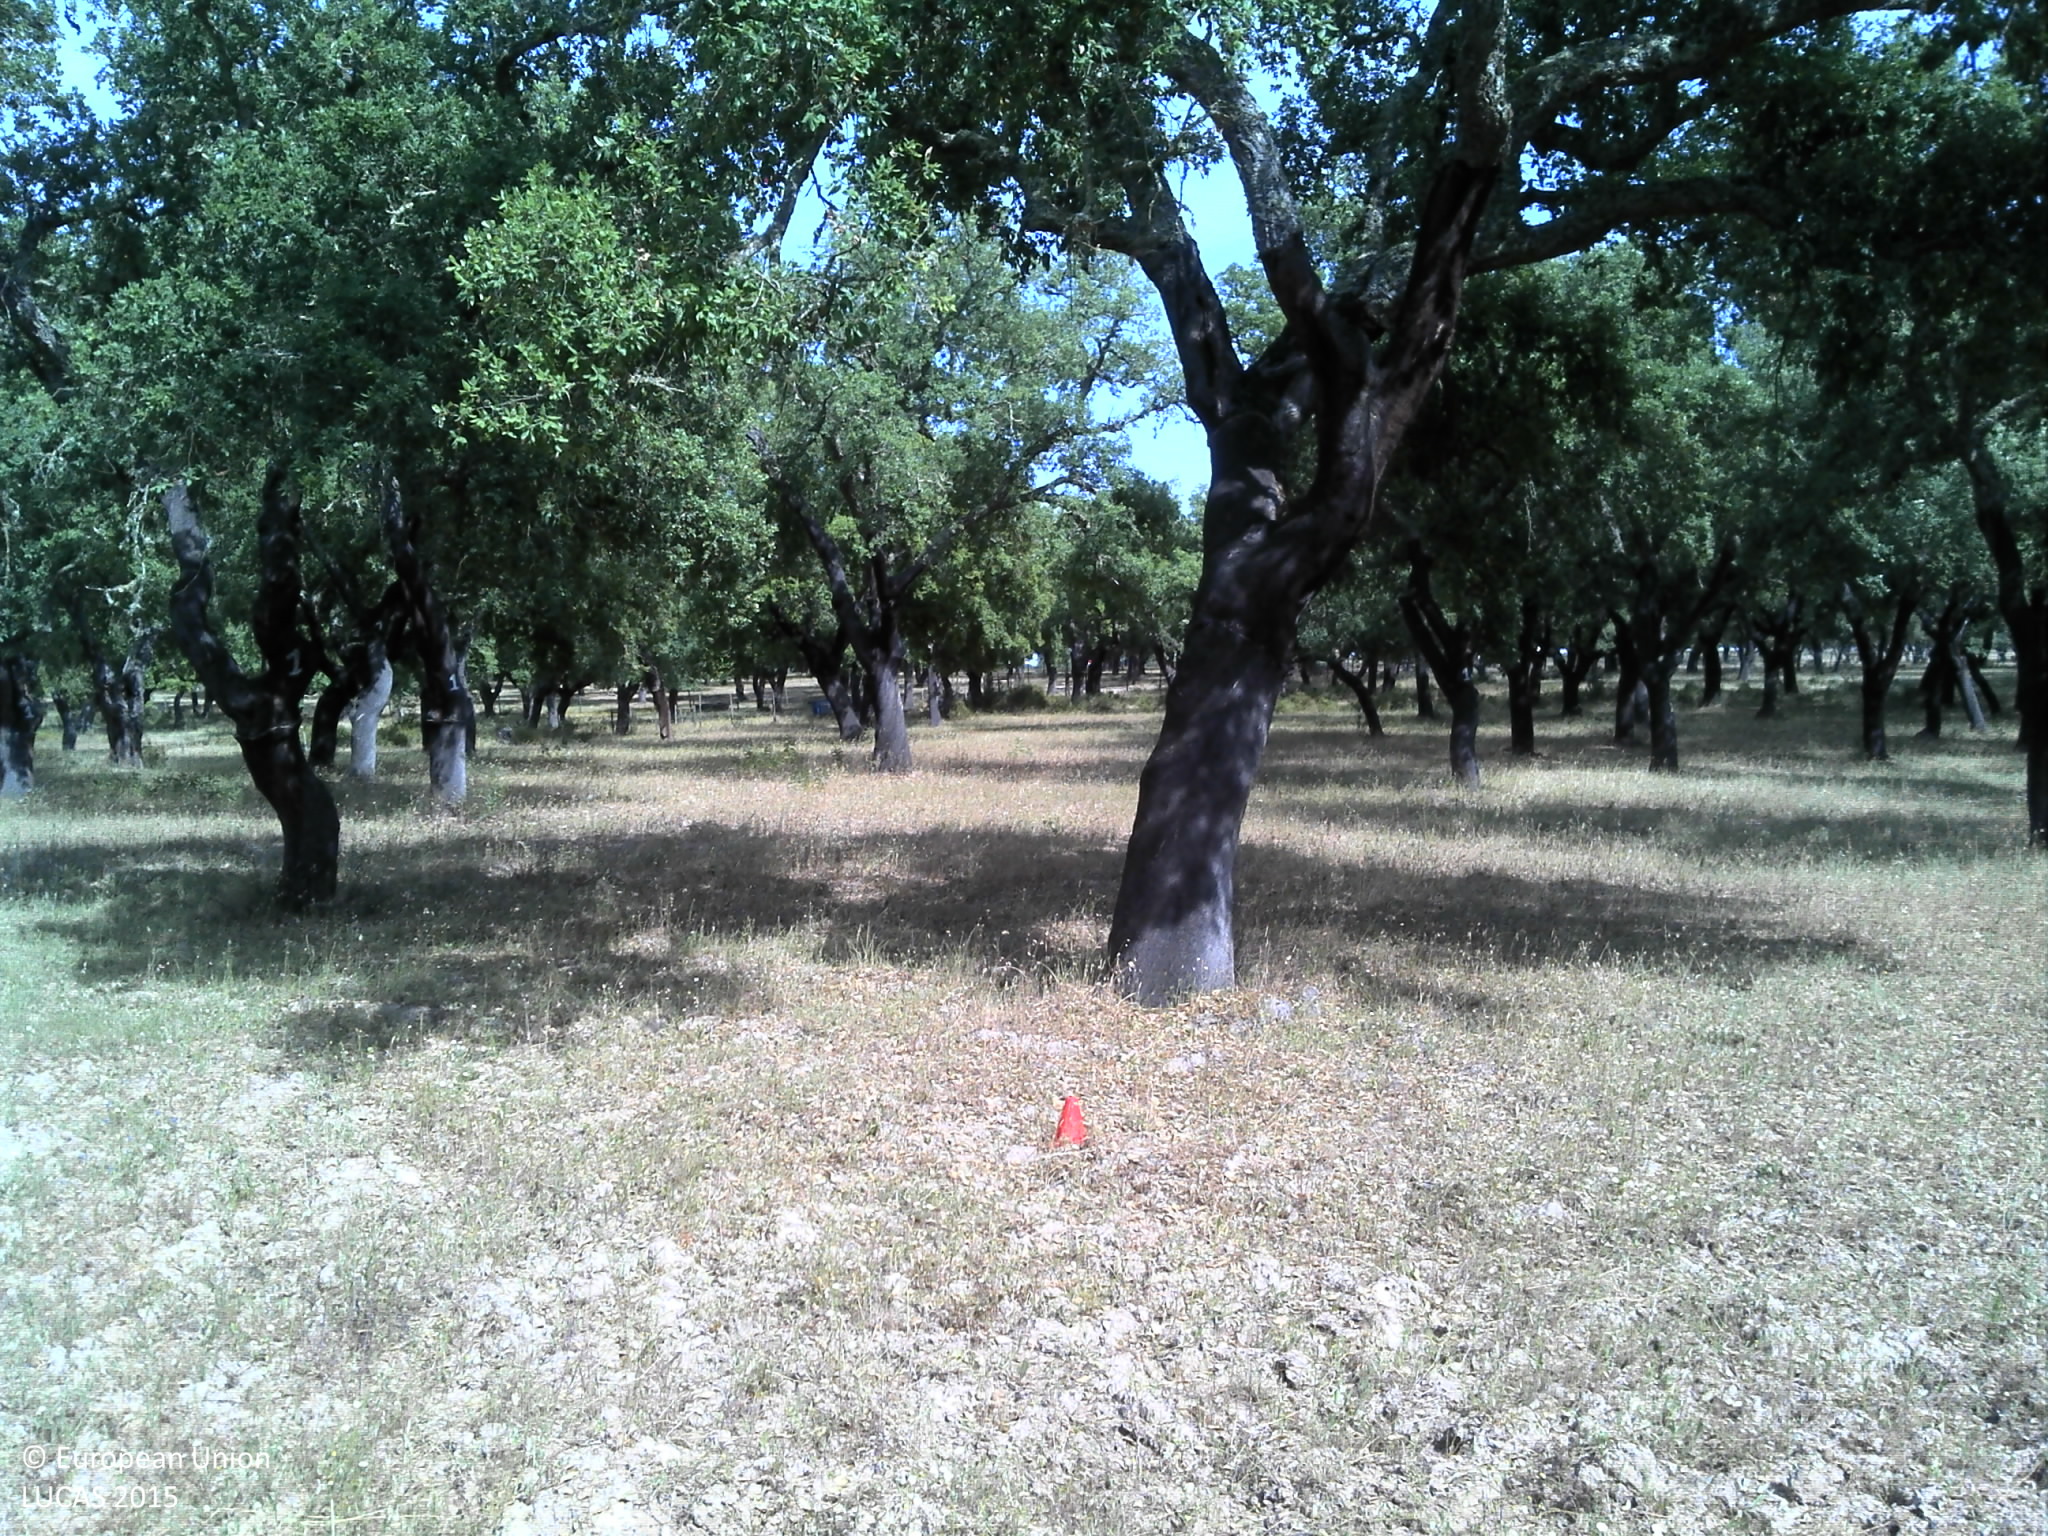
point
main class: Woodland
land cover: Broadleaved woodland
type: broadleaved evergreen forest
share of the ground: 50 - 75 %
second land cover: Grassland without tree/shrub cover
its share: 10 - 25 %
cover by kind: broadleaved forest trees 60 %, herbaceous plants 20 %, unconsolidated bare surface 20 %
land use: Forestry
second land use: Agriculture (excluding fallow land and kitchen gardens)
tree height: > 5 m
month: May
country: PT
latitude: 38.0694
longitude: -8.3819
